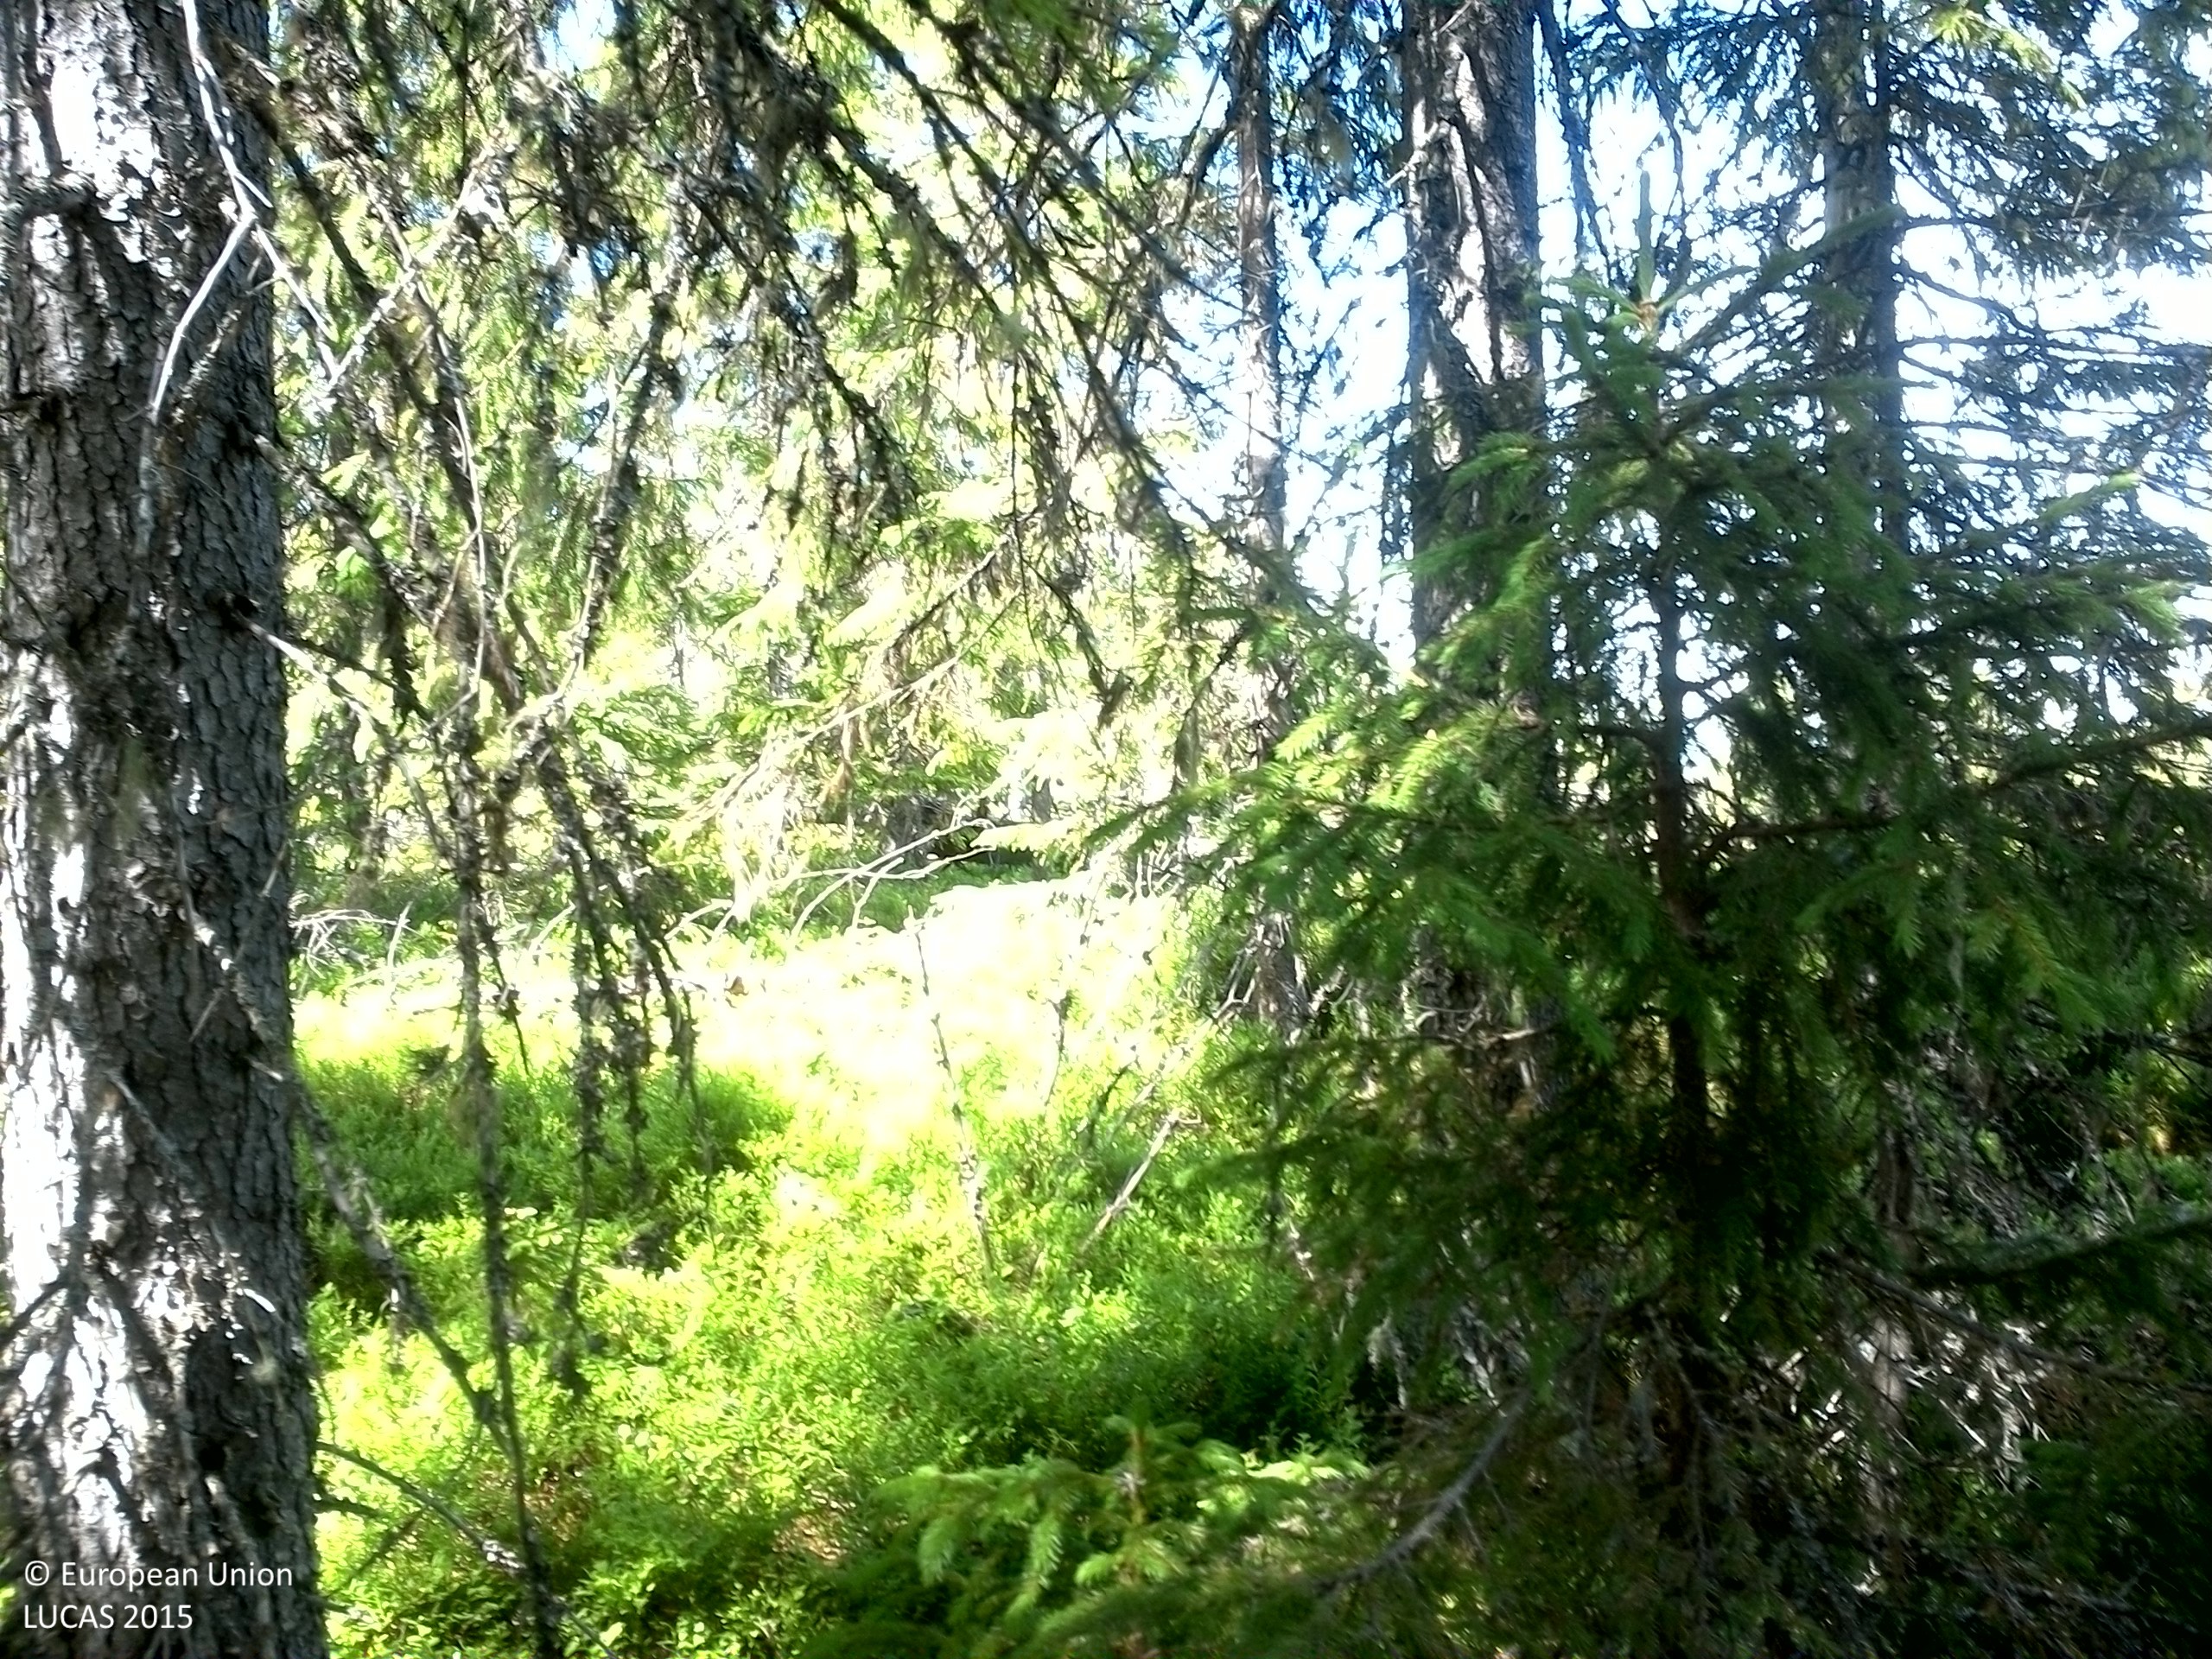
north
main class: Woodland
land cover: Spruce dominated coniferous woodland
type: boreal forest
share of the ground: 50 - 75 %
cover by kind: coniferous forest trees 60 %, shrubs 30 %, broadleaved forest trees 10 %
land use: Forestry
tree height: > 5 m
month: June
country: SE
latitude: 62.8485
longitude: 17.7371
